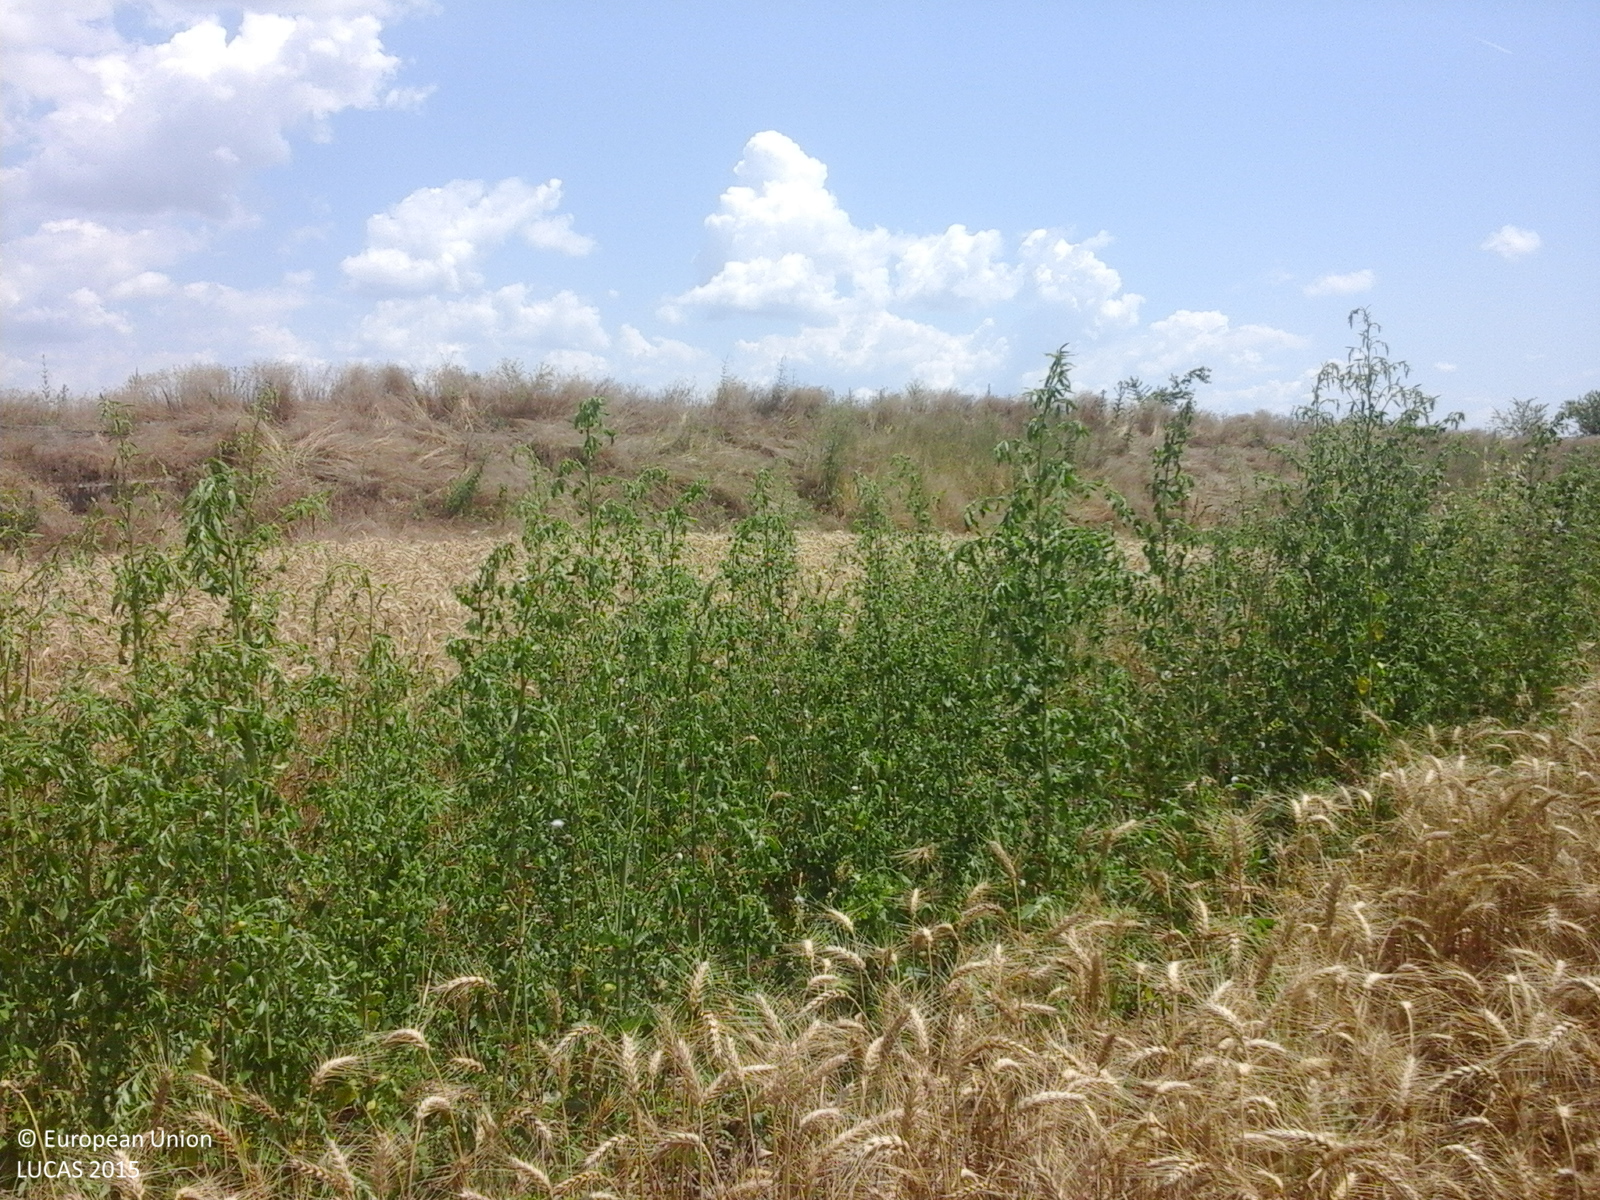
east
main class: Cropland
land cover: Common wheat
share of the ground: > 75 %
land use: Agriculture (excluding fallow land and kitchen gardens)
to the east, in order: Common wheat; Spontaneously vegetated surfaces; Ditches and canals; Spontaneously vegetated surfaces; Ditches and canals; Spontaneously vegetated surfaces; Common wheat; Spontaneously vegetated surfaces; Ditches and canals; Spontaneously vegetated surfaces; Common wheat
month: June
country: RO
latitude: 44.0889
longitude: 26.5872
